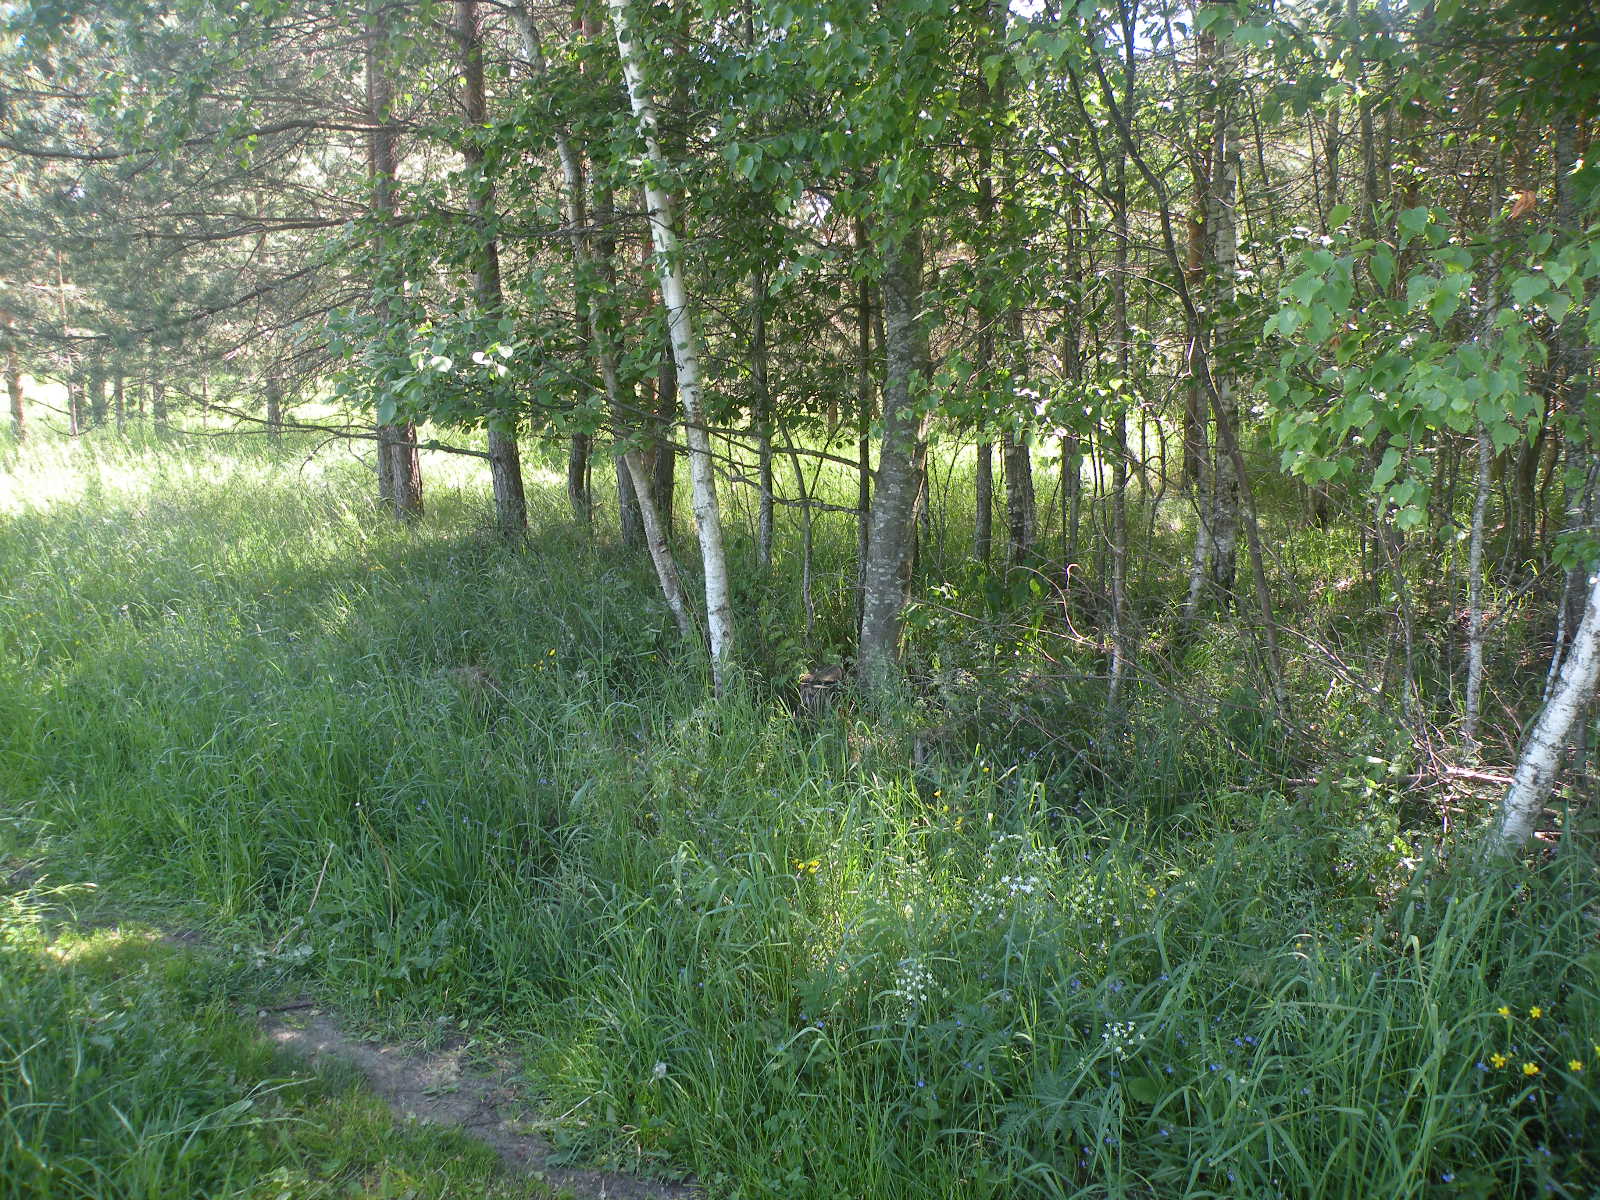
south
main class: Grassland
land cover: Grassland without tree/shrub cover
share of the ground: > 75 %
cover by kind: herbaceous plants 100 %
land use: Agriculture (excluding fallow land and kitchen gardens)
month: June
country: LV
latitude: 55.9311
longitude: 26.9548
